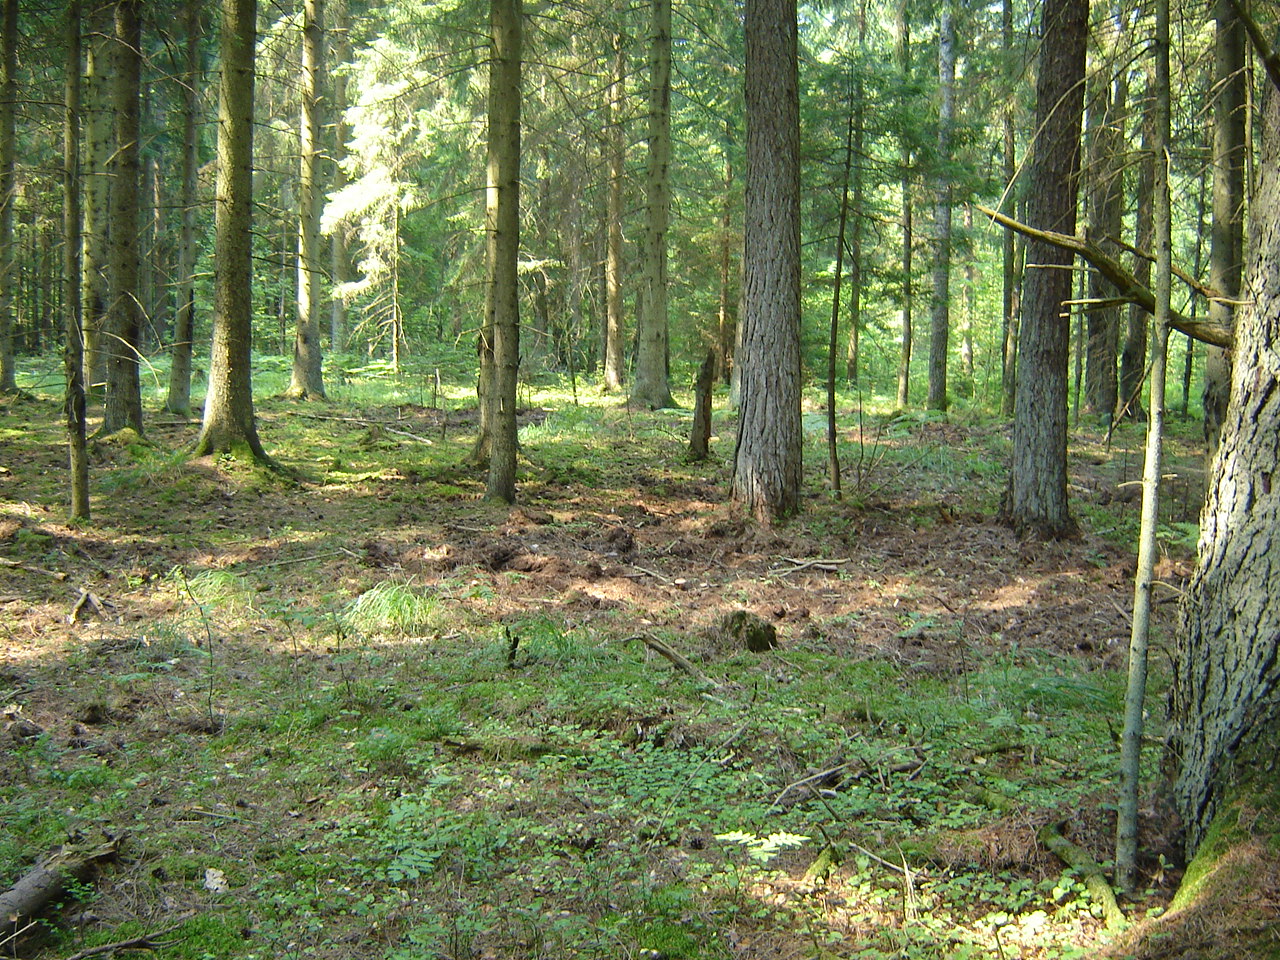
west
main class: Woodland
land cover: Spruce dominated coniferous woodland
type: hemiboreal forest and nemoral coniferous forest and mixed broadleaved-coniferous forest
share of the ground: > 75 %
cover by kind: coniferous forest trees 75 %, broadleaved forest trees 10 %, lichens and mosses 10 %, herbaceous plants 5 %
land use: Forestry
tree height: > 5 m
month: August
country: LT
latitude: 54.8951
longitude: 25.0045
